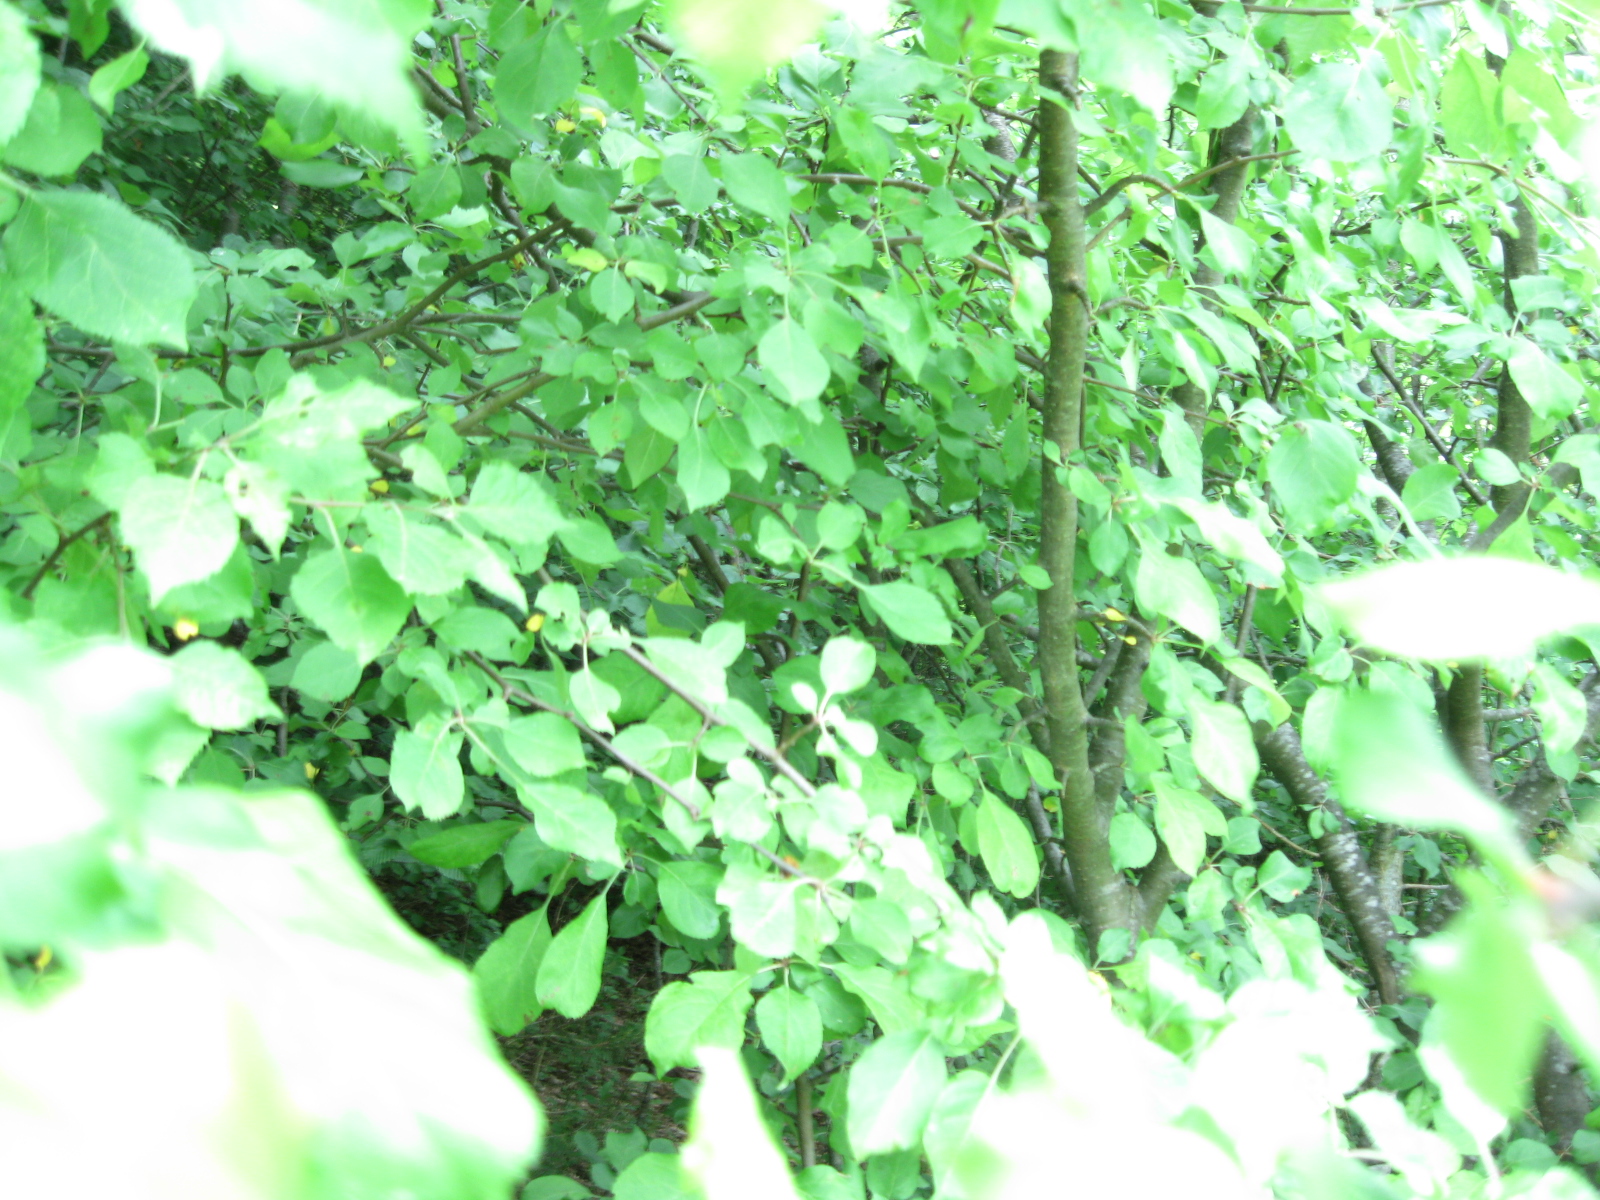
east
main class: Woodland
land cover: Broadleaved woodland
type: non-riverine alder, birch or aspen forest
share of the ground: > 75 %
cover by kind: broadleaved forest trees 85 %, herbaceous plants 10 %, lichens and mosses 5 %
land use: Semi-natural and natural areas not in use
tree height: > 5 m
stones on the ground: < 10 %
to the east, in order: Broadleaved woodland; Pine dominated mixed woodland; Shrubland without tree cover; Tracks; Broadleaved woodland; Artificial constructions in urban areas
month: June
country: LT
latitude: 55.2510
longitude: 23.4988
